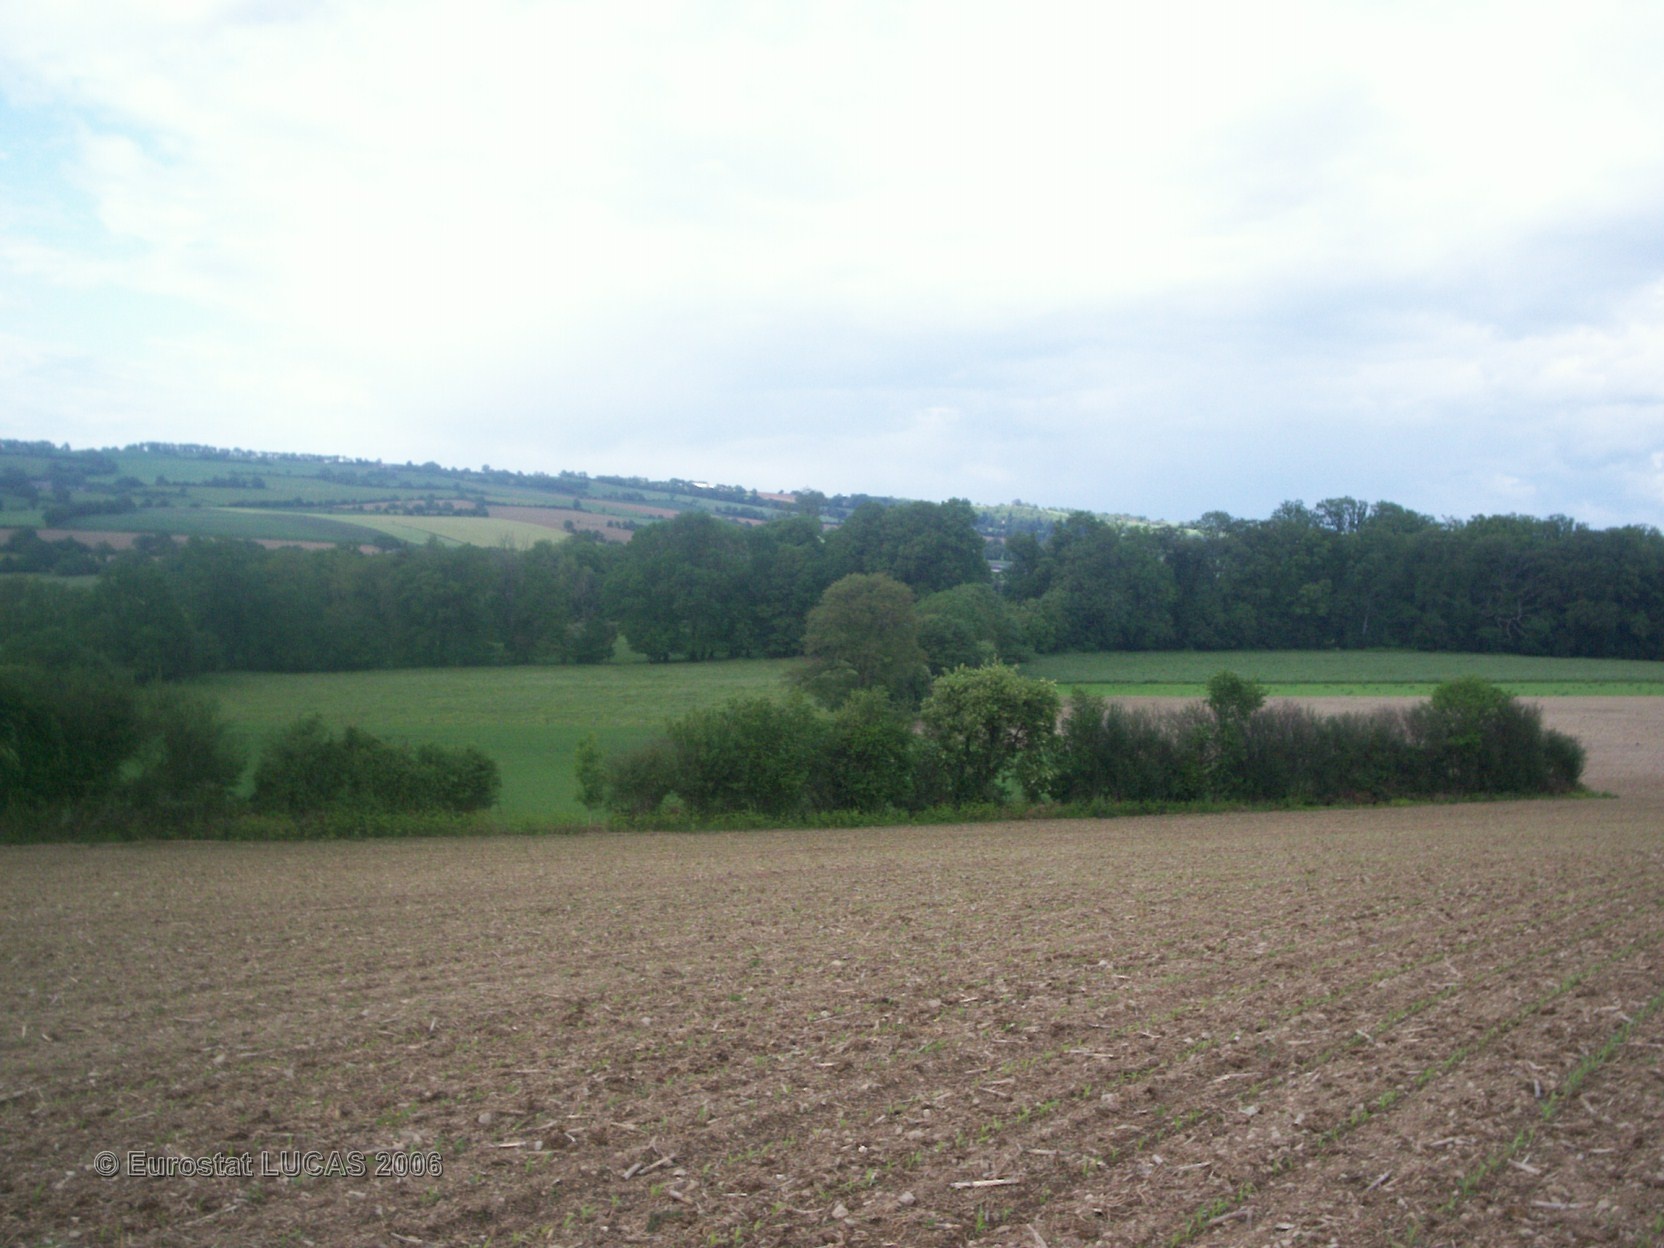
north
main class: Cropland
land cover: Maize
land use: Agriculture (excluding fallow land and kitchen gardens)
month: May
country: FR
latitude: 48.1808
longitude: -0.2392
